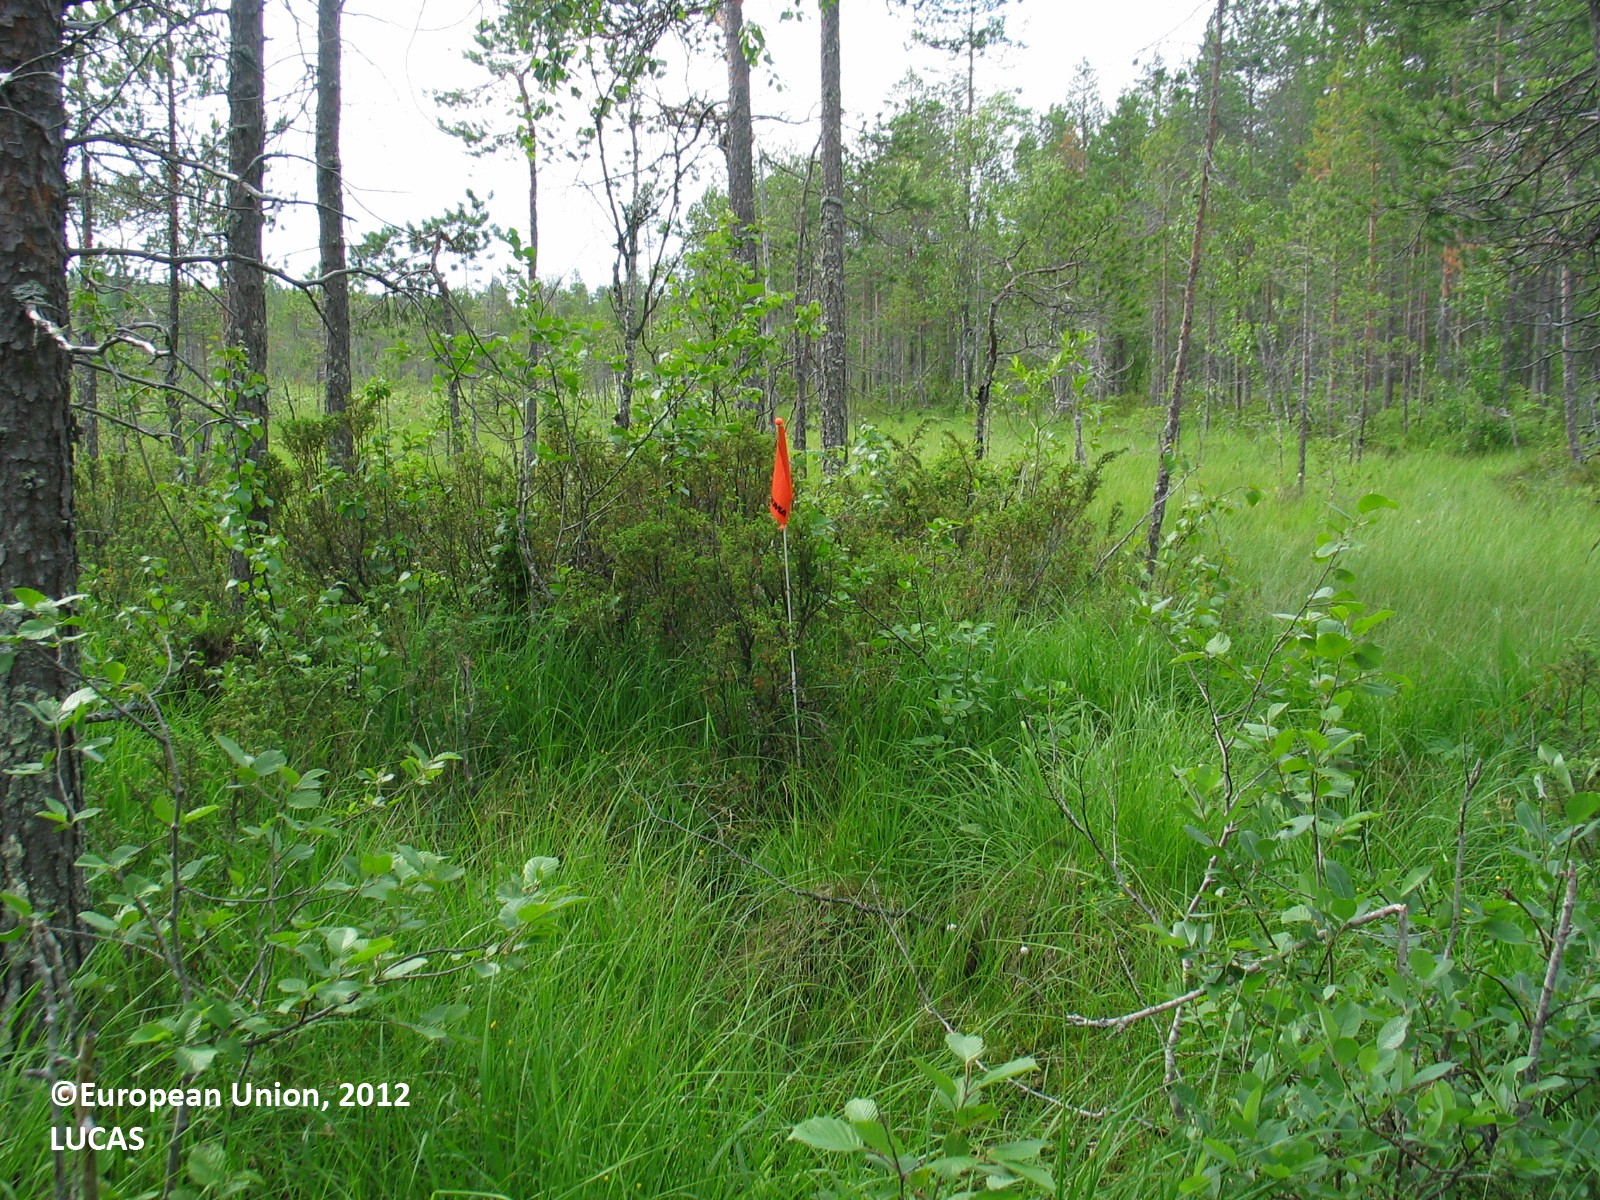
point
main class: Woodland
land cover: Pine dominated coniferous woodland
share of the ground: 25 - 50 %
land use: Semi-natural and natural areas not in use
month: July
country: FI
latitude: 65.9761
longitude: 25.1424
